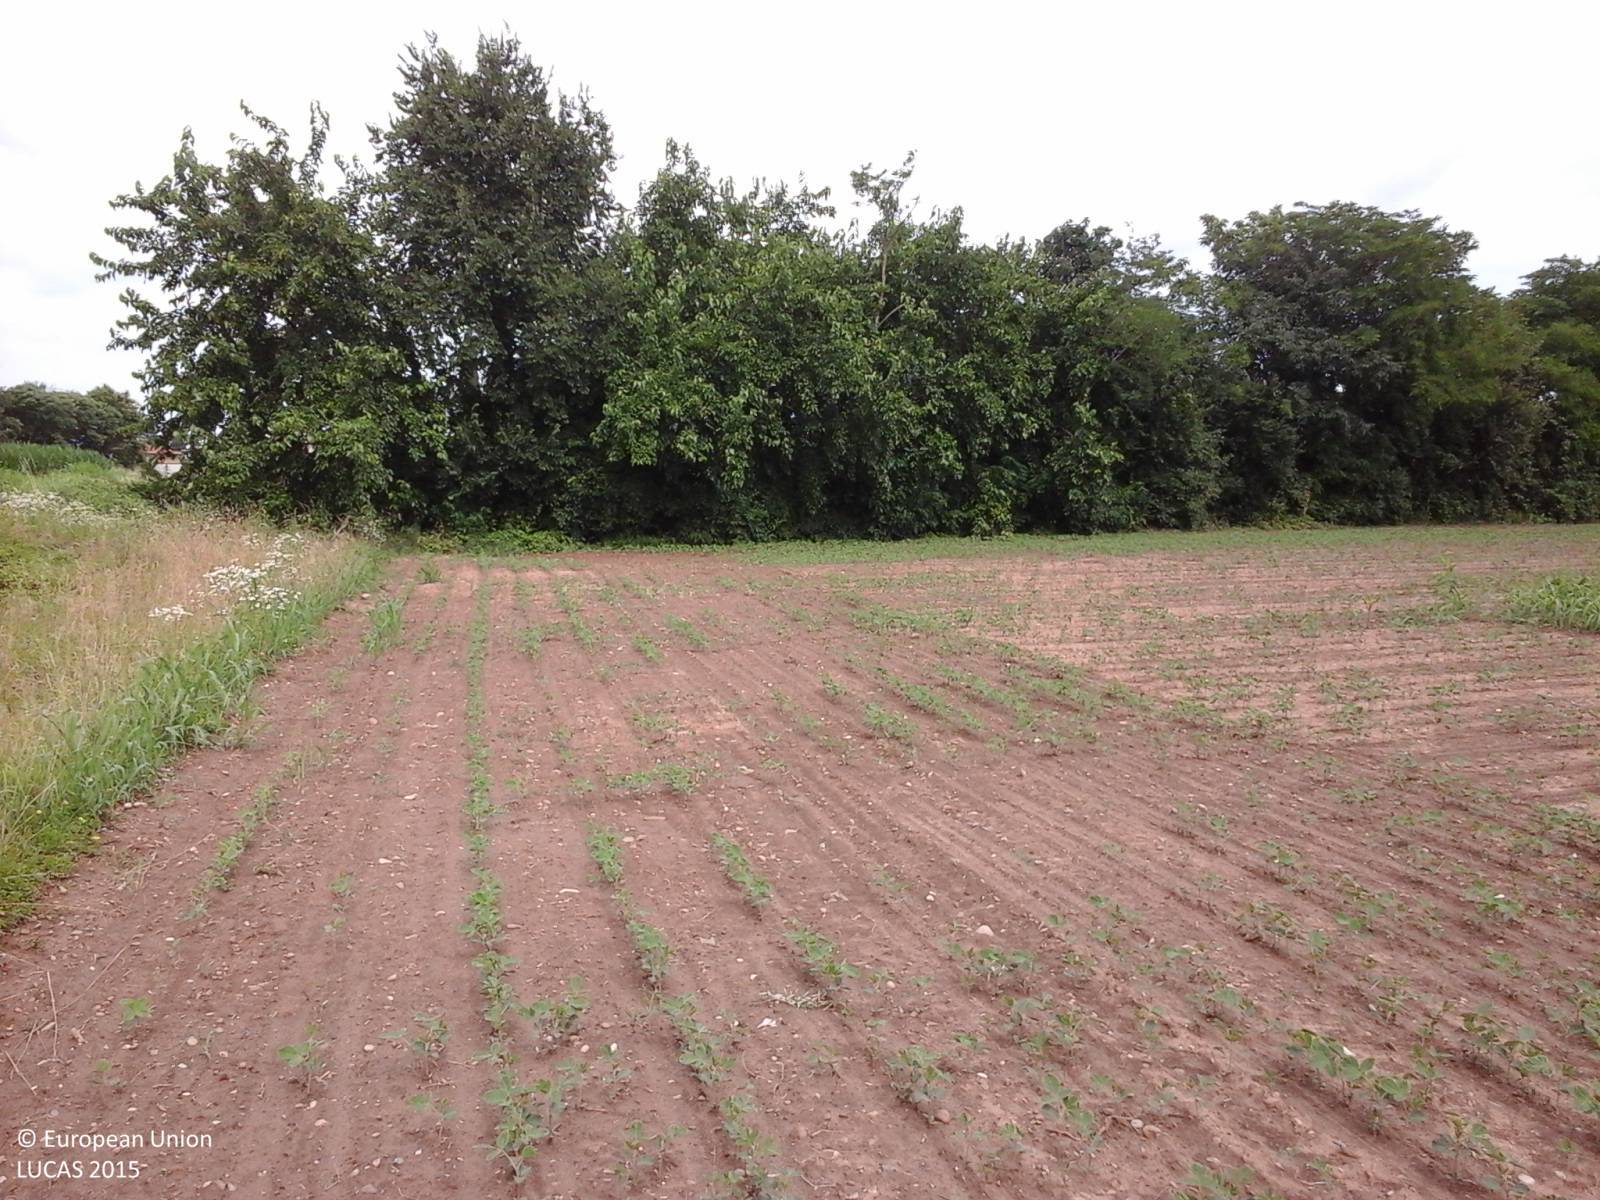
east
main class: Cropland
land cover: Soya
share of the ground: 10 - 25 %
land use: Agriculture (excluding fallow land and kitchen gardens)
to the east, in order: Soya; Grass margins; Abandoned hedges; Grass margins; Soya; Grassland without tree/shrub cover; Soya
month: June
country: IT
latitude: 45.9958
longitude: 13.2371
